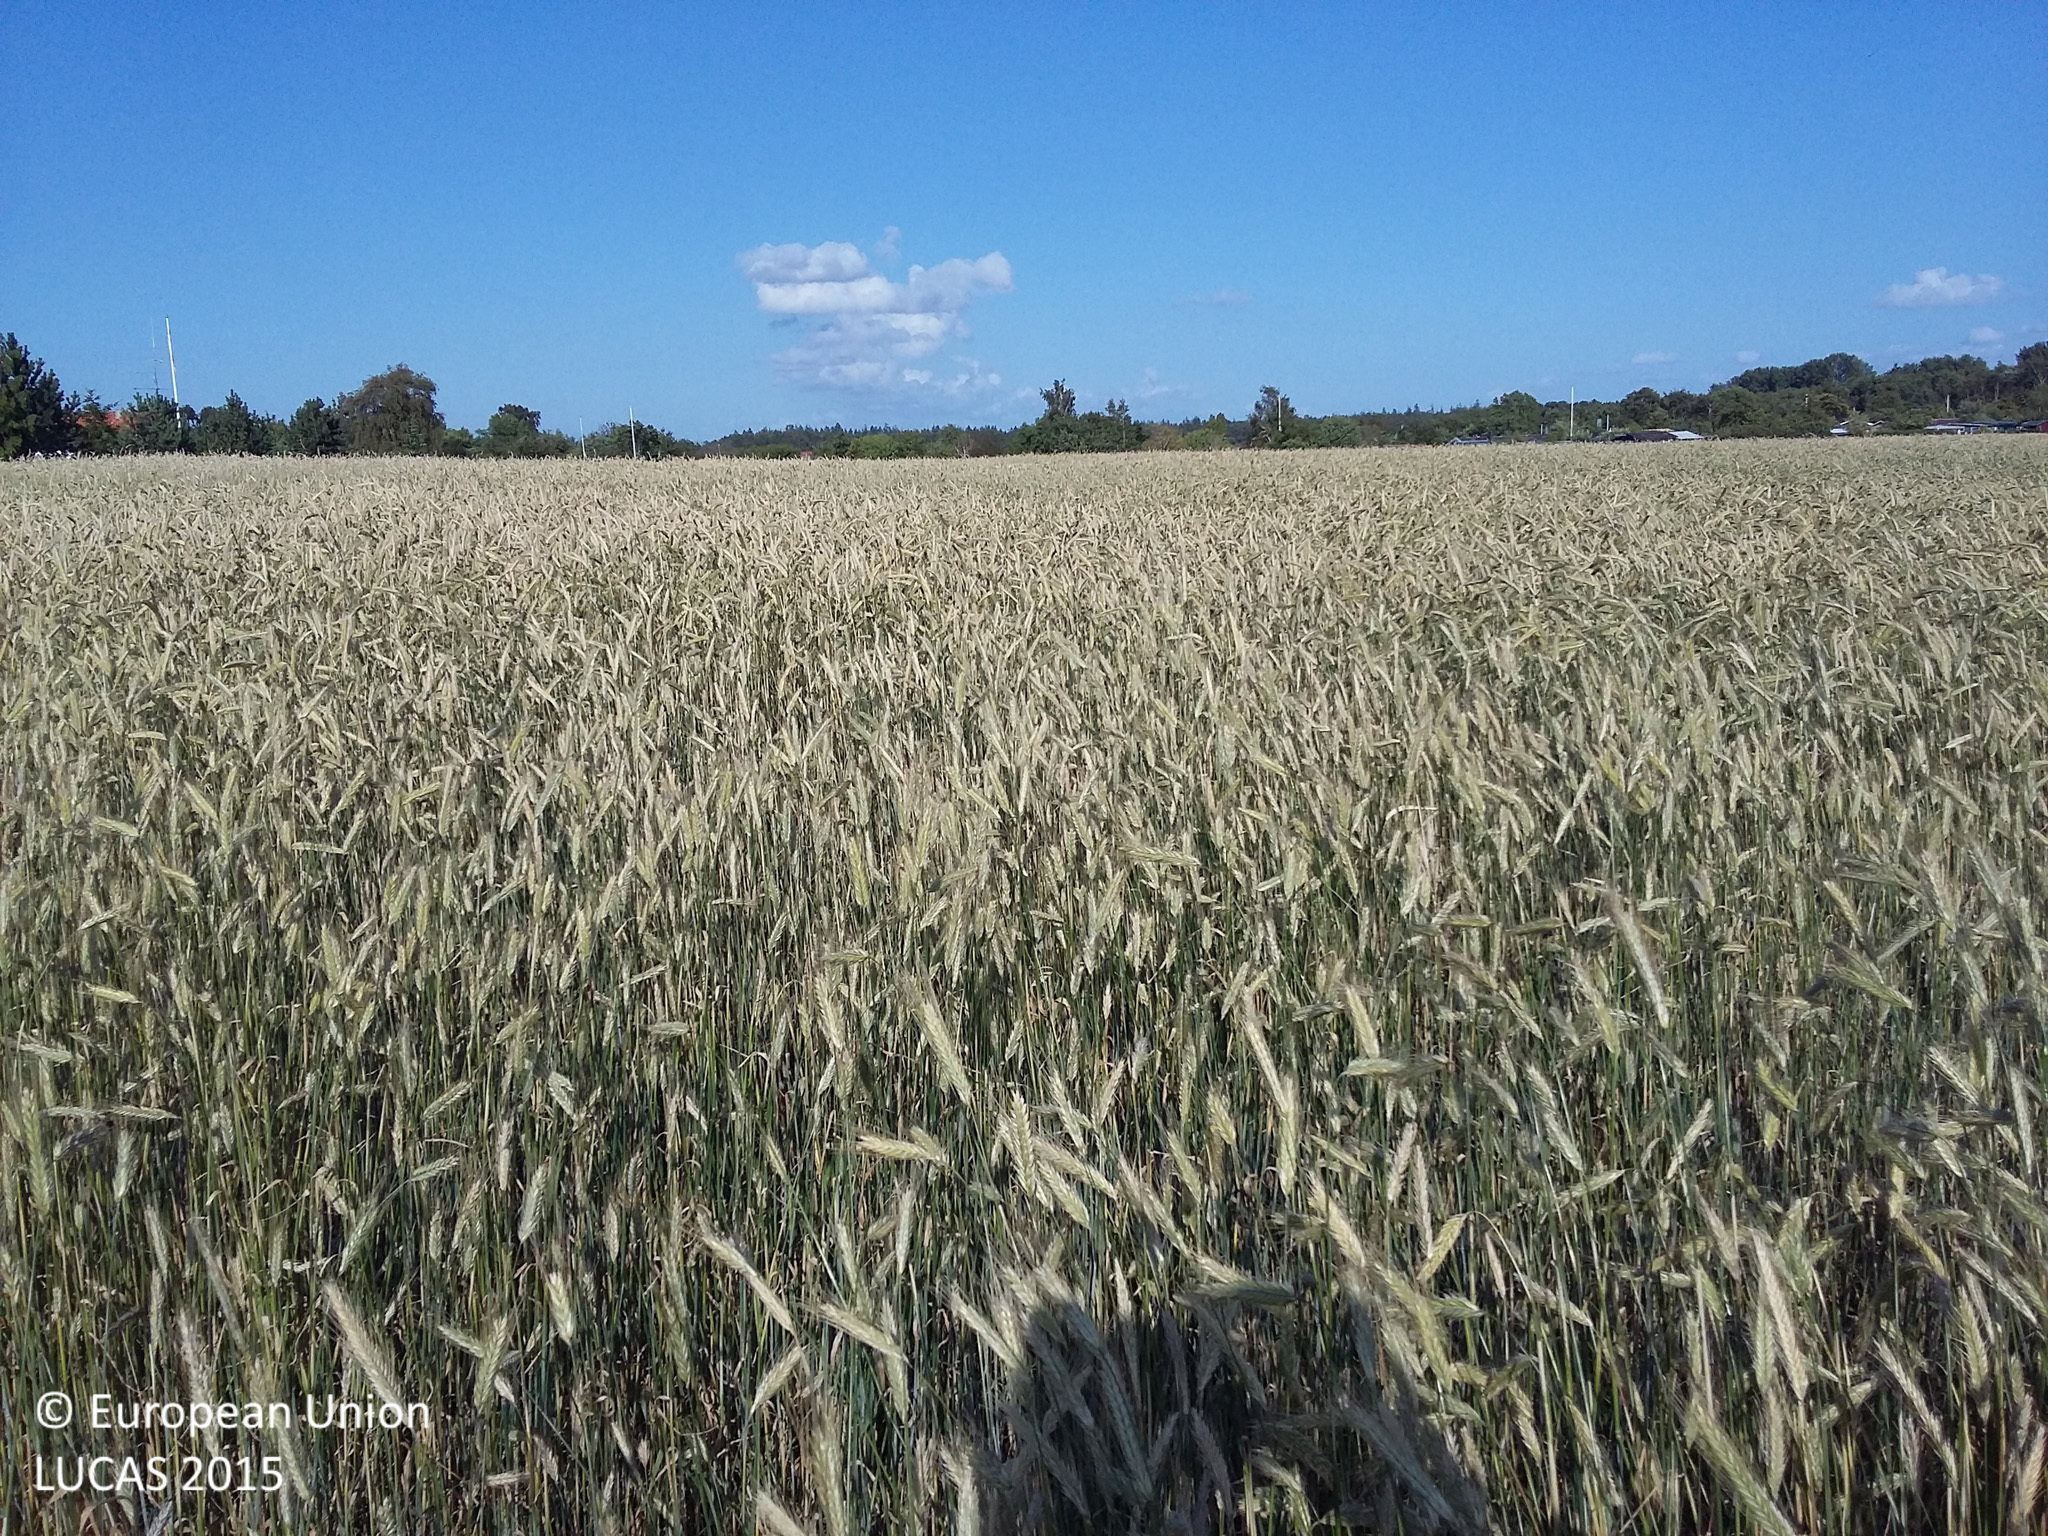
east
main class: Cropland
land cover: Rye
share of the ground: > 75 %
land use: Agriculture (excluding fallow land and kitchen gardens)
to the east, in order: Rye; Artificial constructions in urban areas
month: July
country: DK
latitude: 55.9251
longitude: 11.6787
